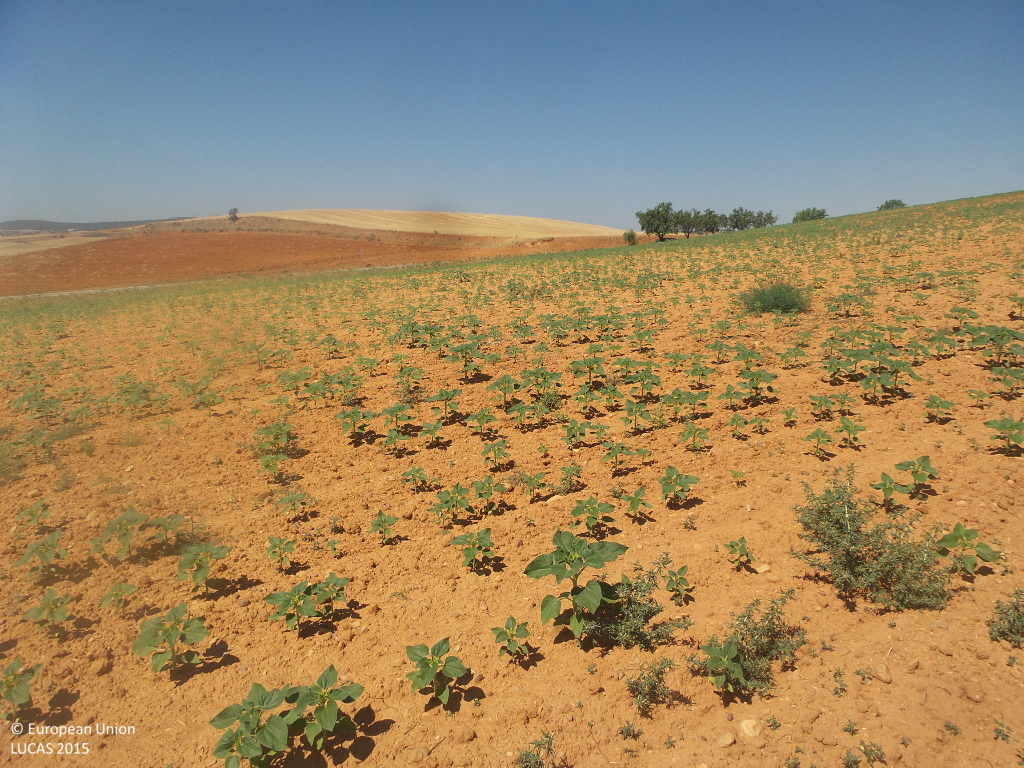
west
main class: Cropland
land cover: Sunflower
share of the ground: < 10 %
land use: Agriculture (excluding fallow land and kitchen gardens)
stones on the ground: < 10 %
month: July
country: ES
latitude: 41.1794
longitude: -1.9352
